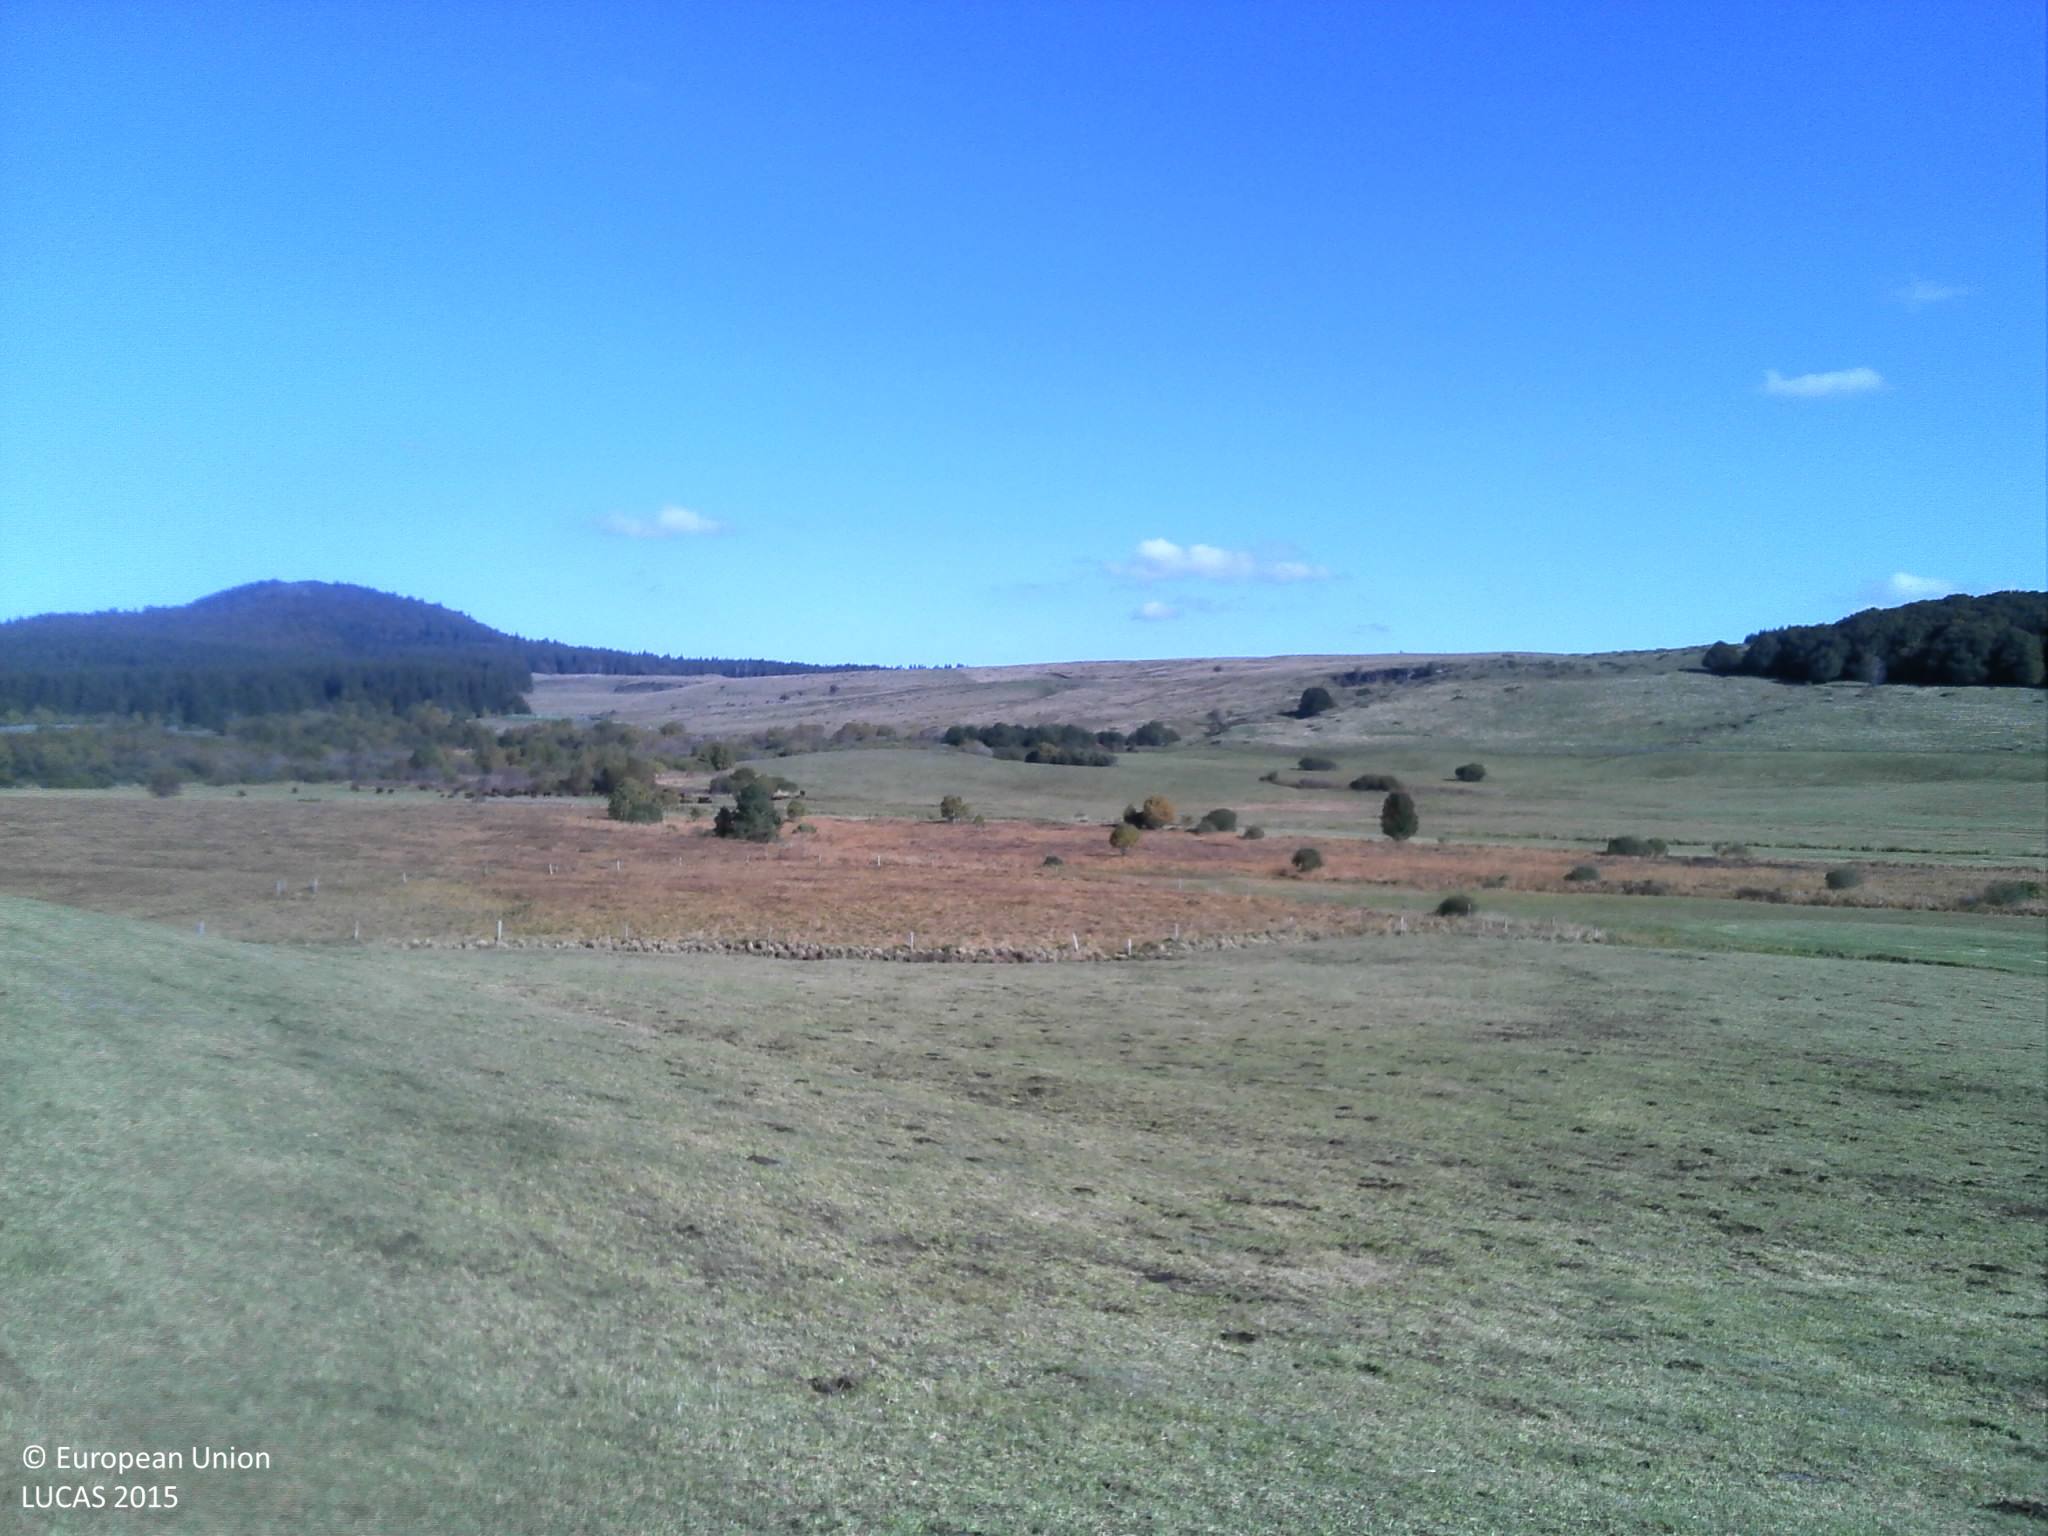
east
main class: Grassland
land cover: Grassland without tree/shrub cover
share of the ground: > 75 %
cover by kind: herbaceous plants 100 %
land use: Agriculture (excluding fallow land and kitchen gardens)
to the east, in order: Grassland without tree/shrub cover; Fences; Peatbogs; Fences; Ditches and canals; Grassland without tree/shrub cover
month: September
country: FR
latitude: 45.4788
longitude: 2.8487
